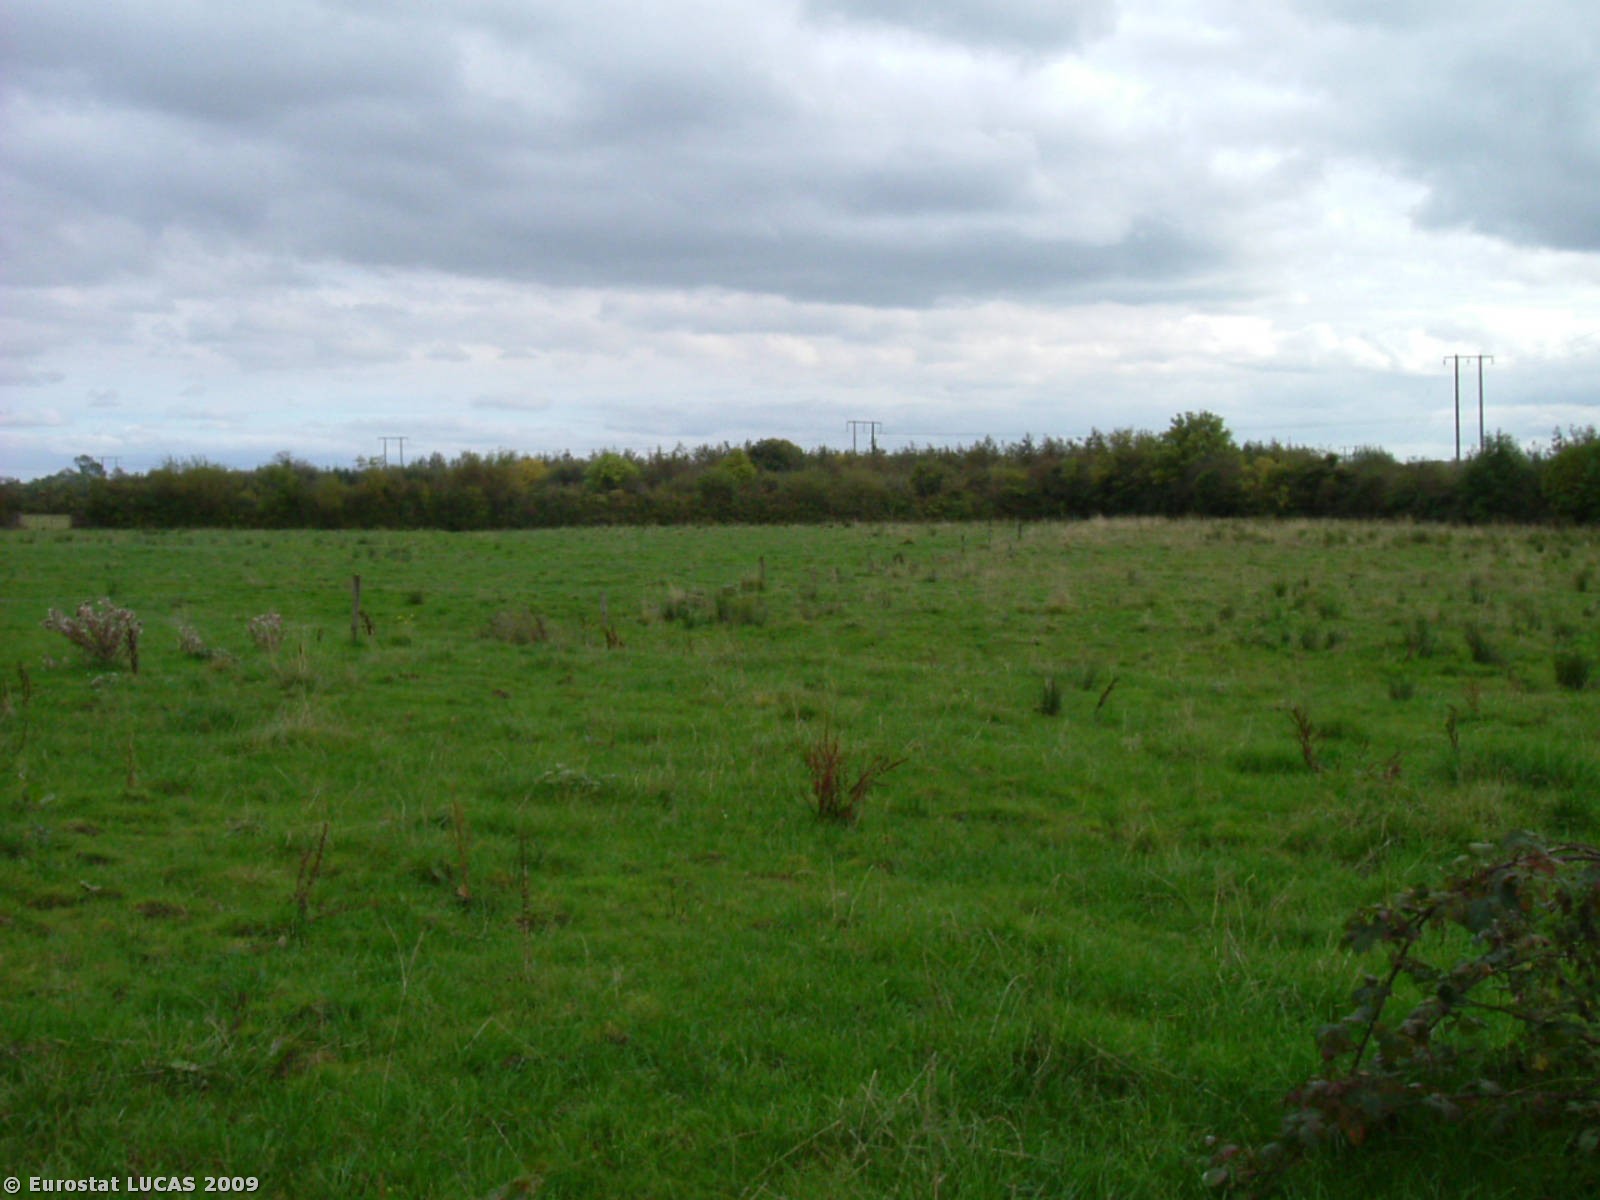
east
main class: Grassland
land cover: Grassland without tree/shrub cover
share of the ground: > 75 %
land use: Agriculture (excluding fallow land and kitchen gardens)
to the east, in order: Grassland without tree/shrub cover; Managed hedges; Grassland without tree/shrub cover
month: October
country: IE
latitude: 52.5380
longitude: -8.2149
